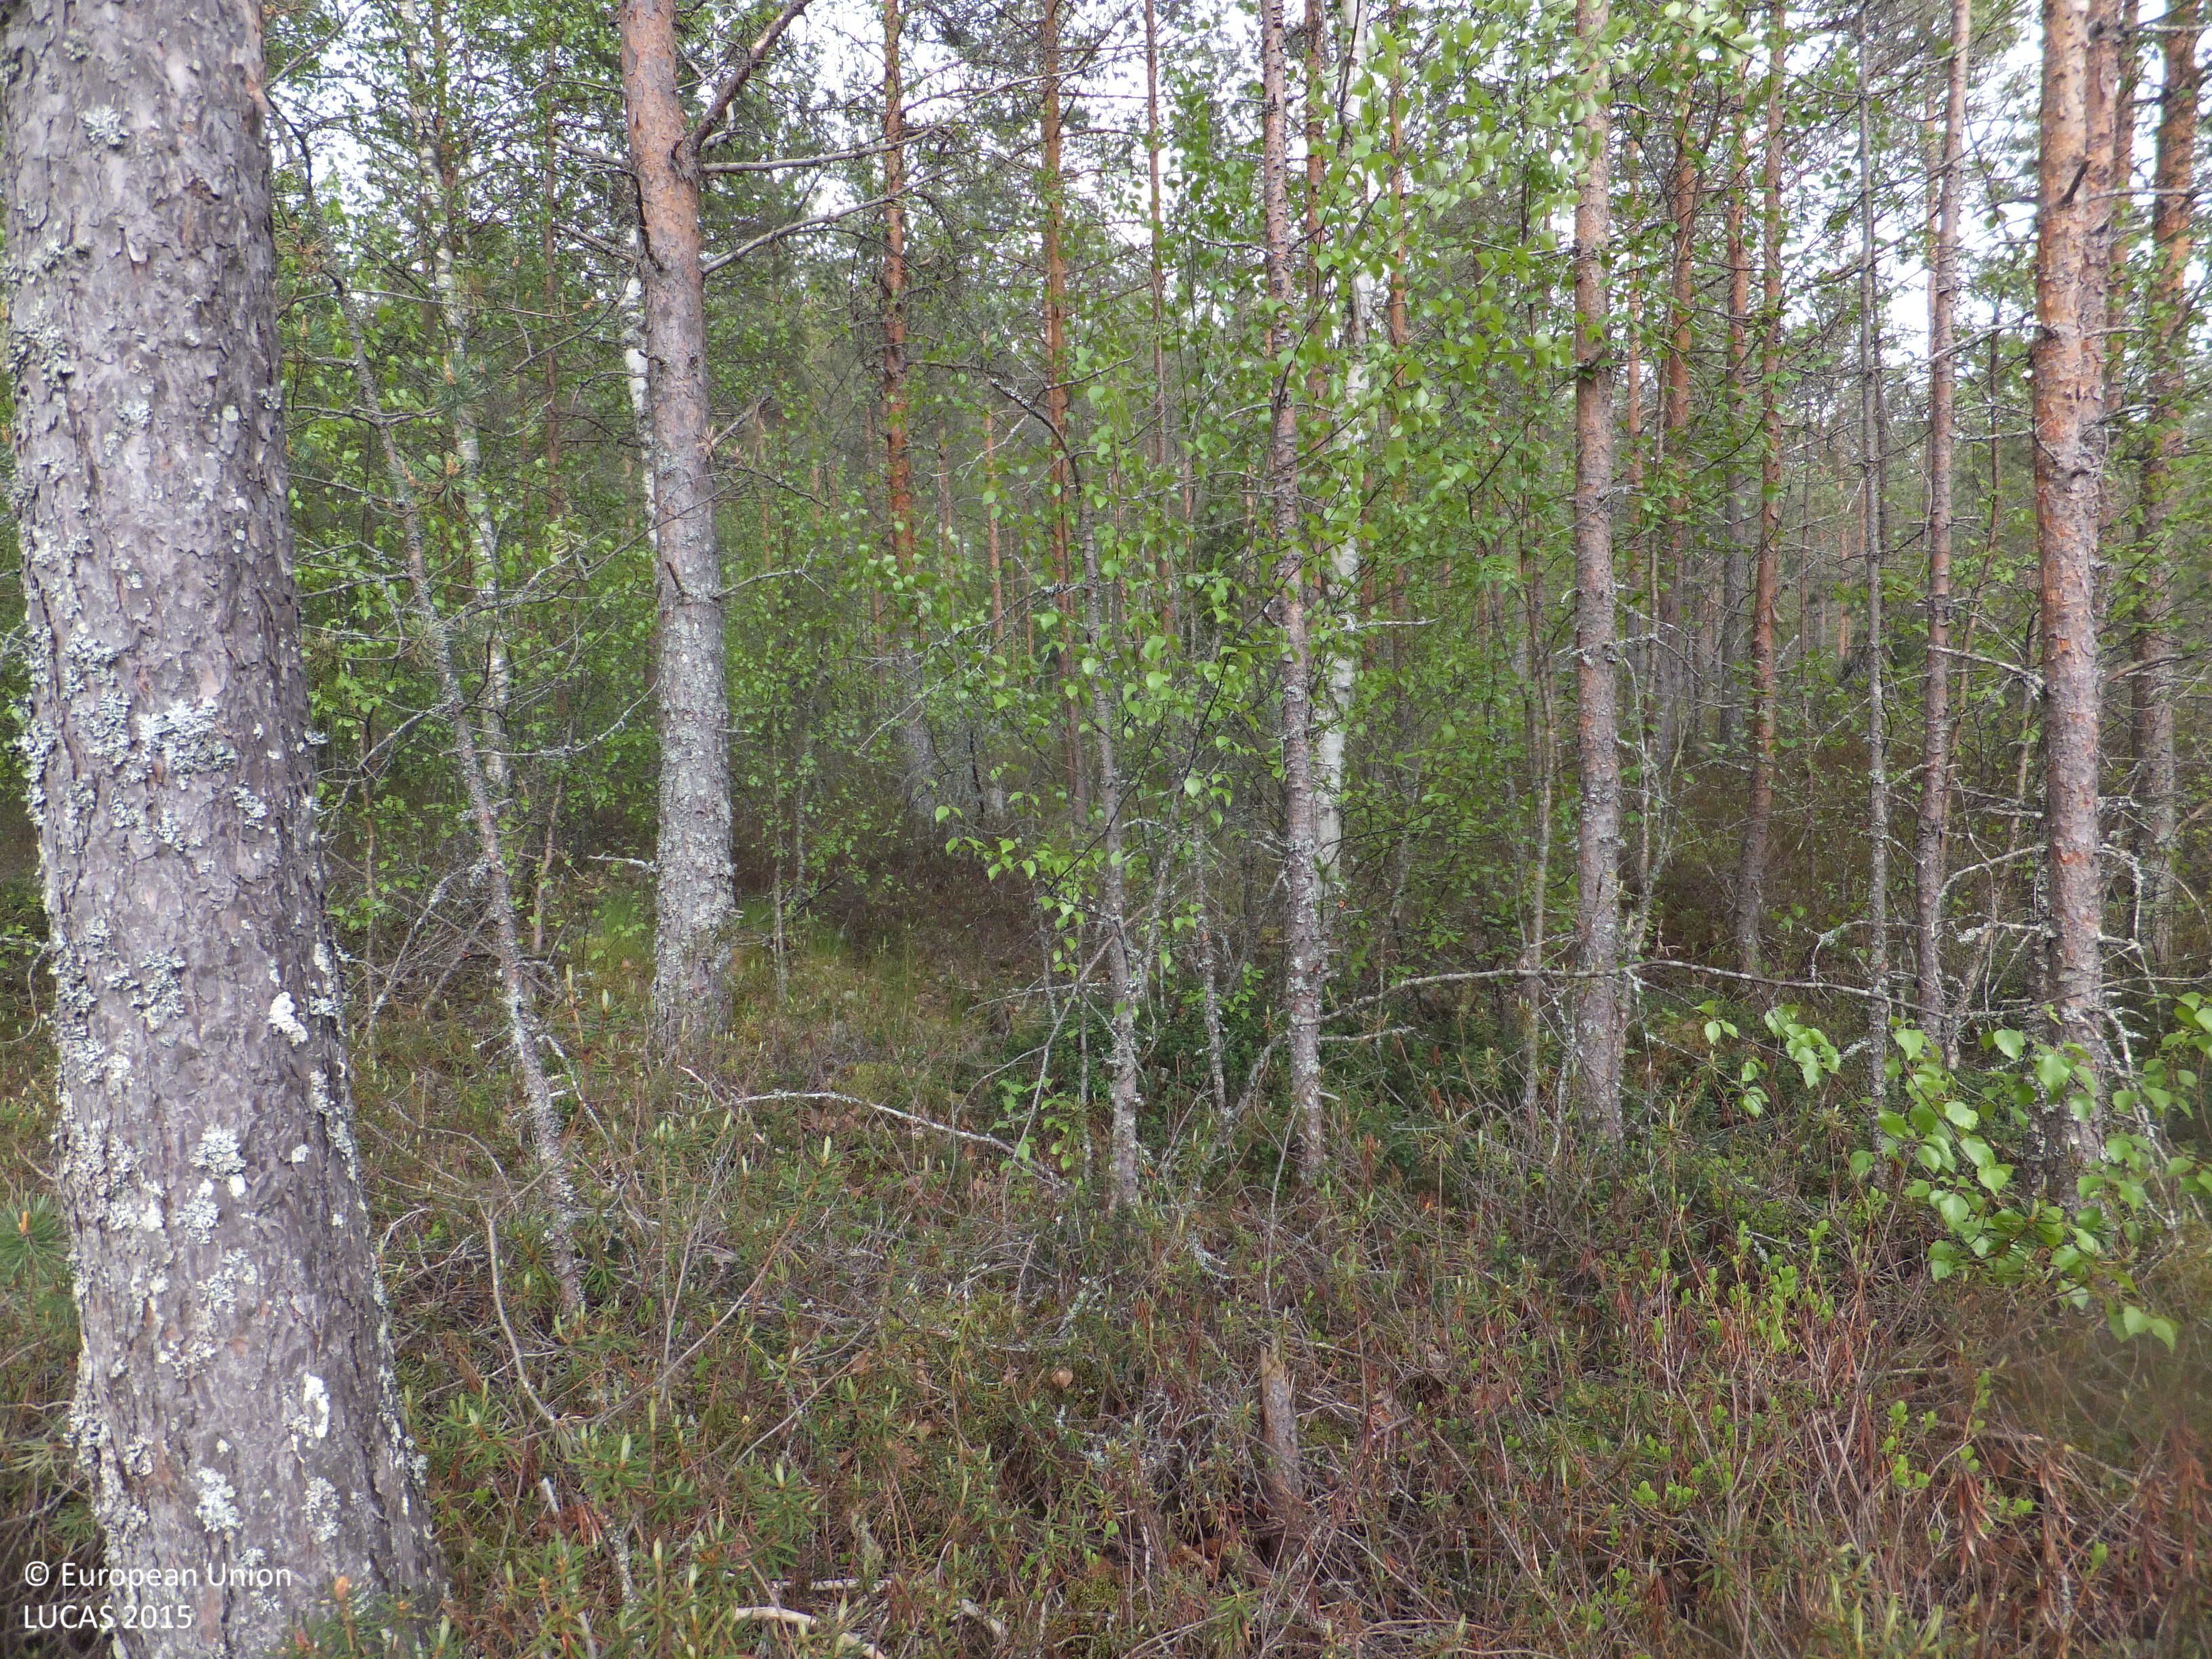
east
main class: Woodland
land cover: Pine dominated coniferous woodland
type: boreal forest
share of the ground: > 75 %
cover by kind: coniferous forest trees 80 %, shrubs 10 %, broadleaved forest trees 5 %, lichens and mosses 5 %
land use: Forestry
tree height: > 5 m
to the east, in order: Pine dominated coniferous woodland; Ditches and canals; Pine dominated coniferous woodland; Pine dominated mixed woodland; Ditches and canals; Pine dominated mixed woodland; Pine dominated coniferous woodland; Tracks
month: June
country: FI
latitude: 63.5470
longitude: 23.2365
